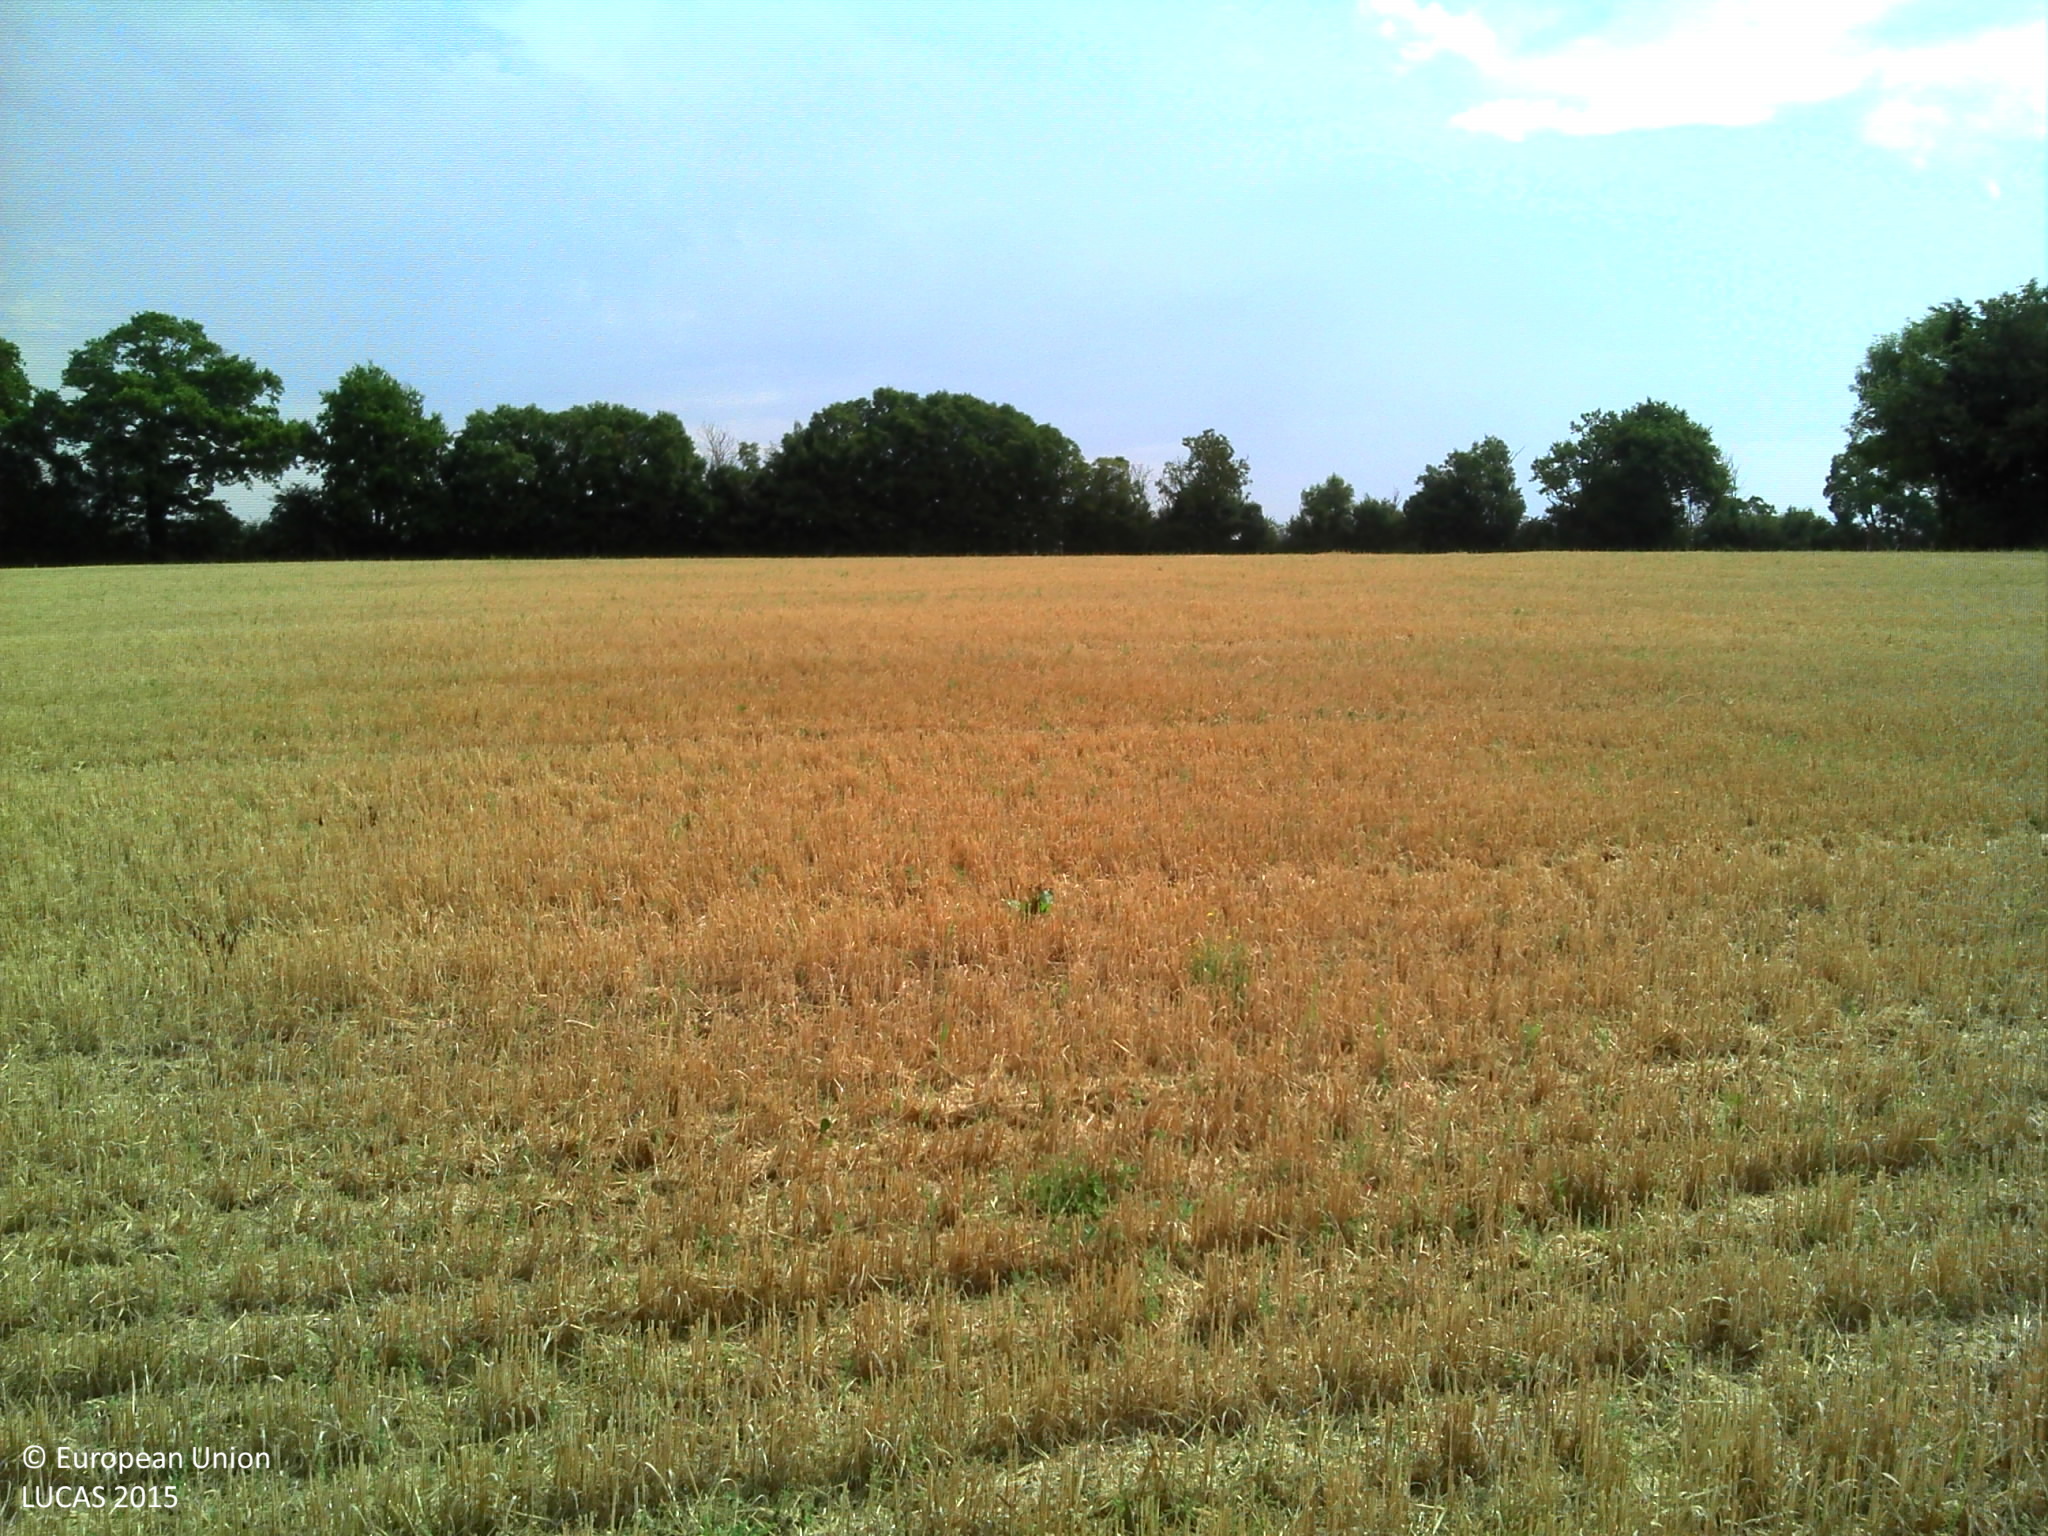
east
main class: Cropland
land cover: Barley
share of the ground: > 75 %
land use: Agriculture (excluding fallow land and kitchen gardens)
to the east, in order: Barley; Ditches and canals; Fences; Broadleaved woodland; Common wheat
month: August
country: FR
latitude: 46.9515
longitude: -1.4576
